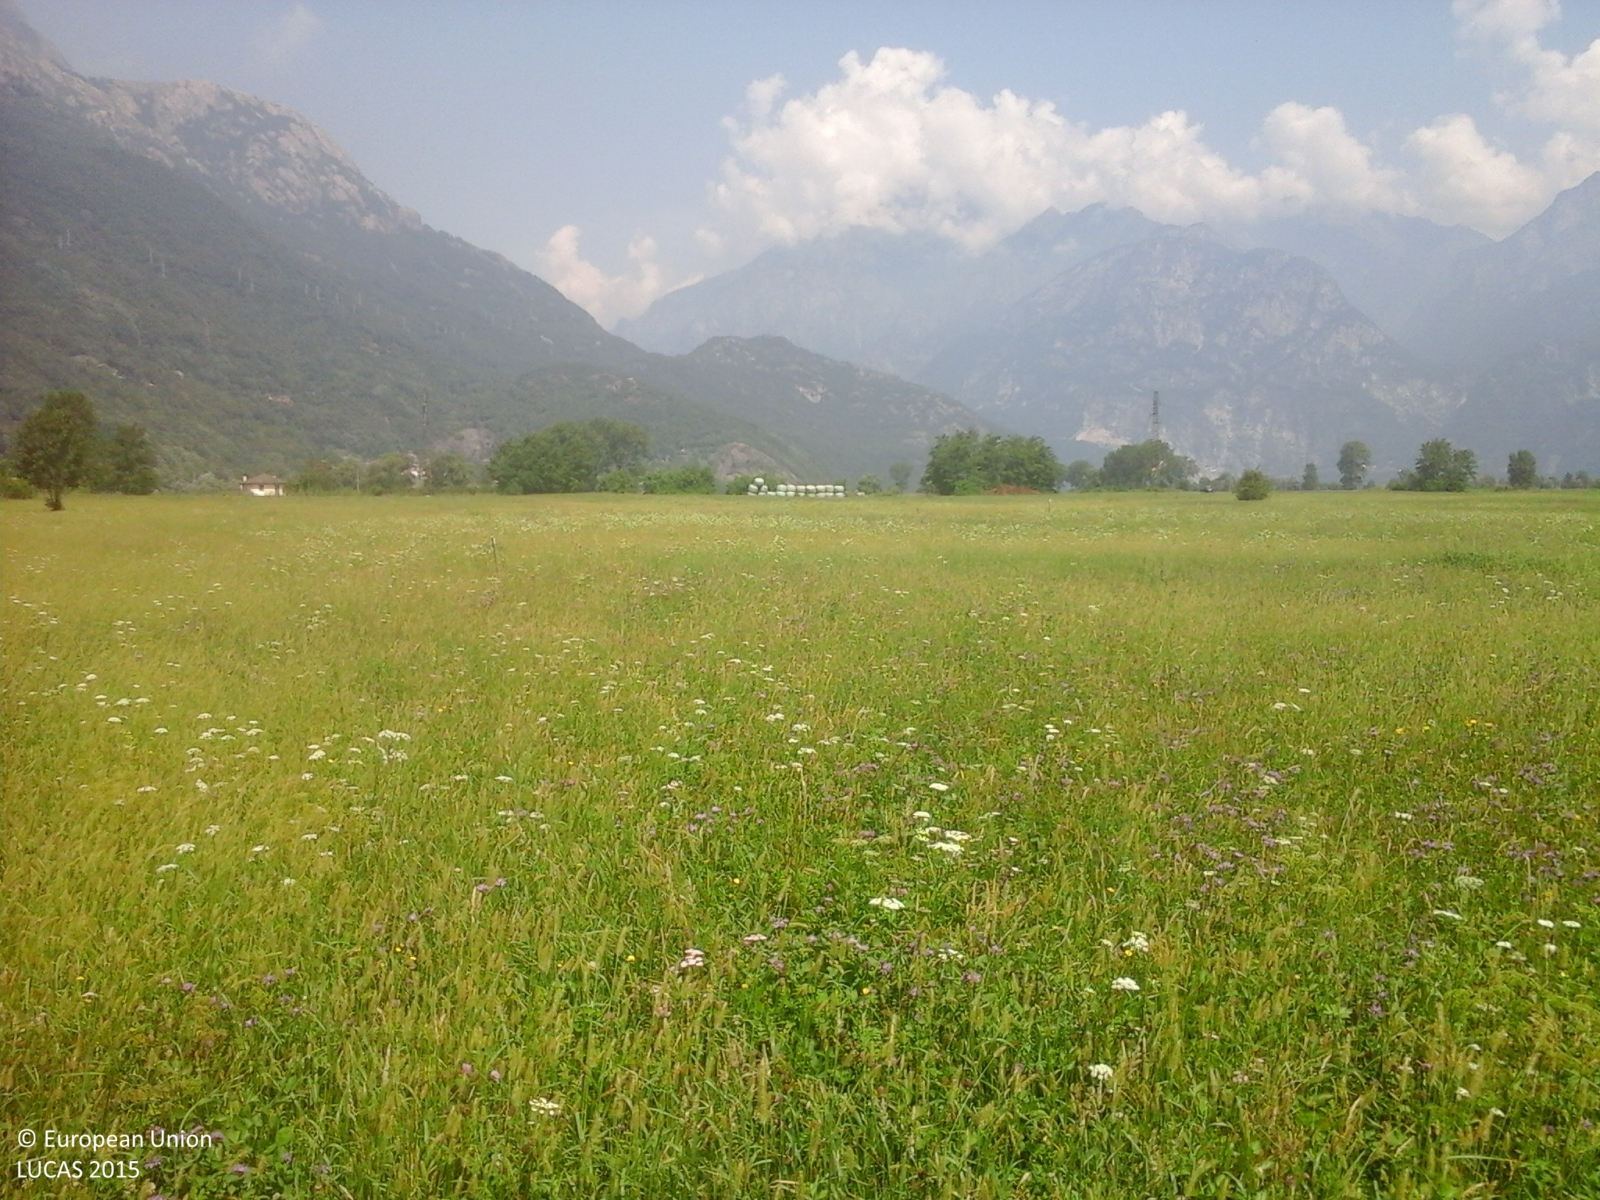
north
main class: Grassland
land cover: Grassland without tree/shrub cover
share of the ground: > 75 %
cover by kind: herbaceous plants 100 %
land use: Agriculture (excluding fallow land and kitchen gardens)
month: August
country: IT
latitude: 46.1695
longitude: 9.4180
